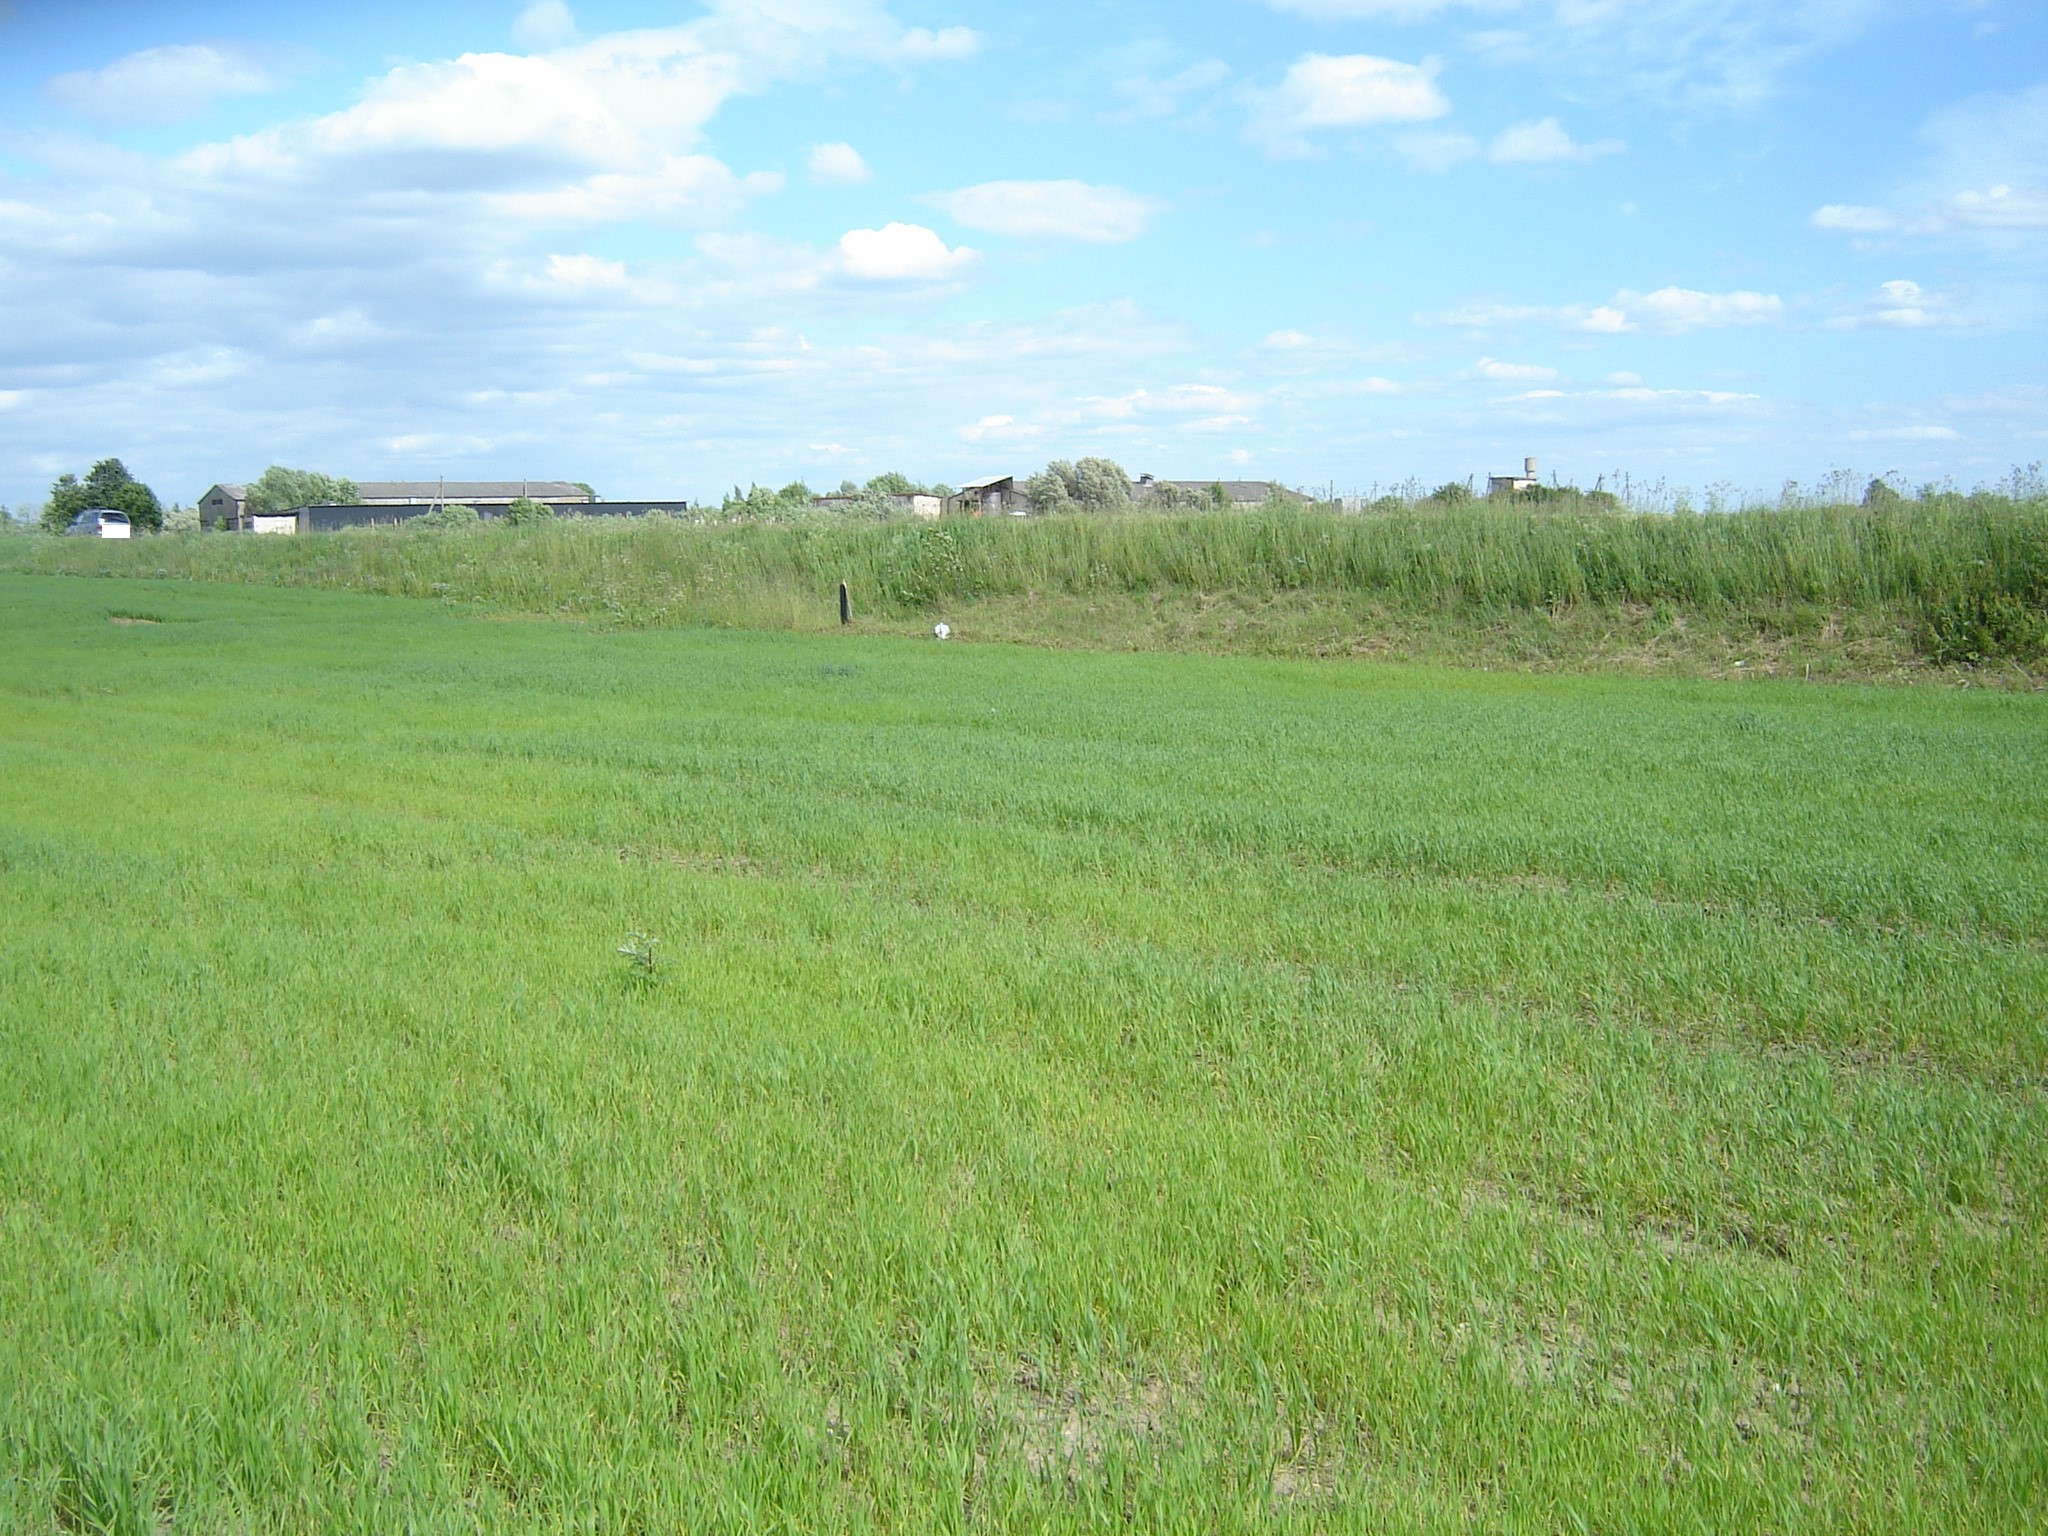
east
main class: Cropland
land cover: Common wheat
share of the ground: > 75 %
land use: Agriculture (excluding fallow land and kitchen gardens)
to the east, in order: Common wheat; Spontaneously vegetated surfaces; Paved roads, cycling and walking lanes; Grass margins; Grassland without tree/shrub cover; Common wheat
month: June
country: LT
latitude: 55.3849
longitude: 24.7383
